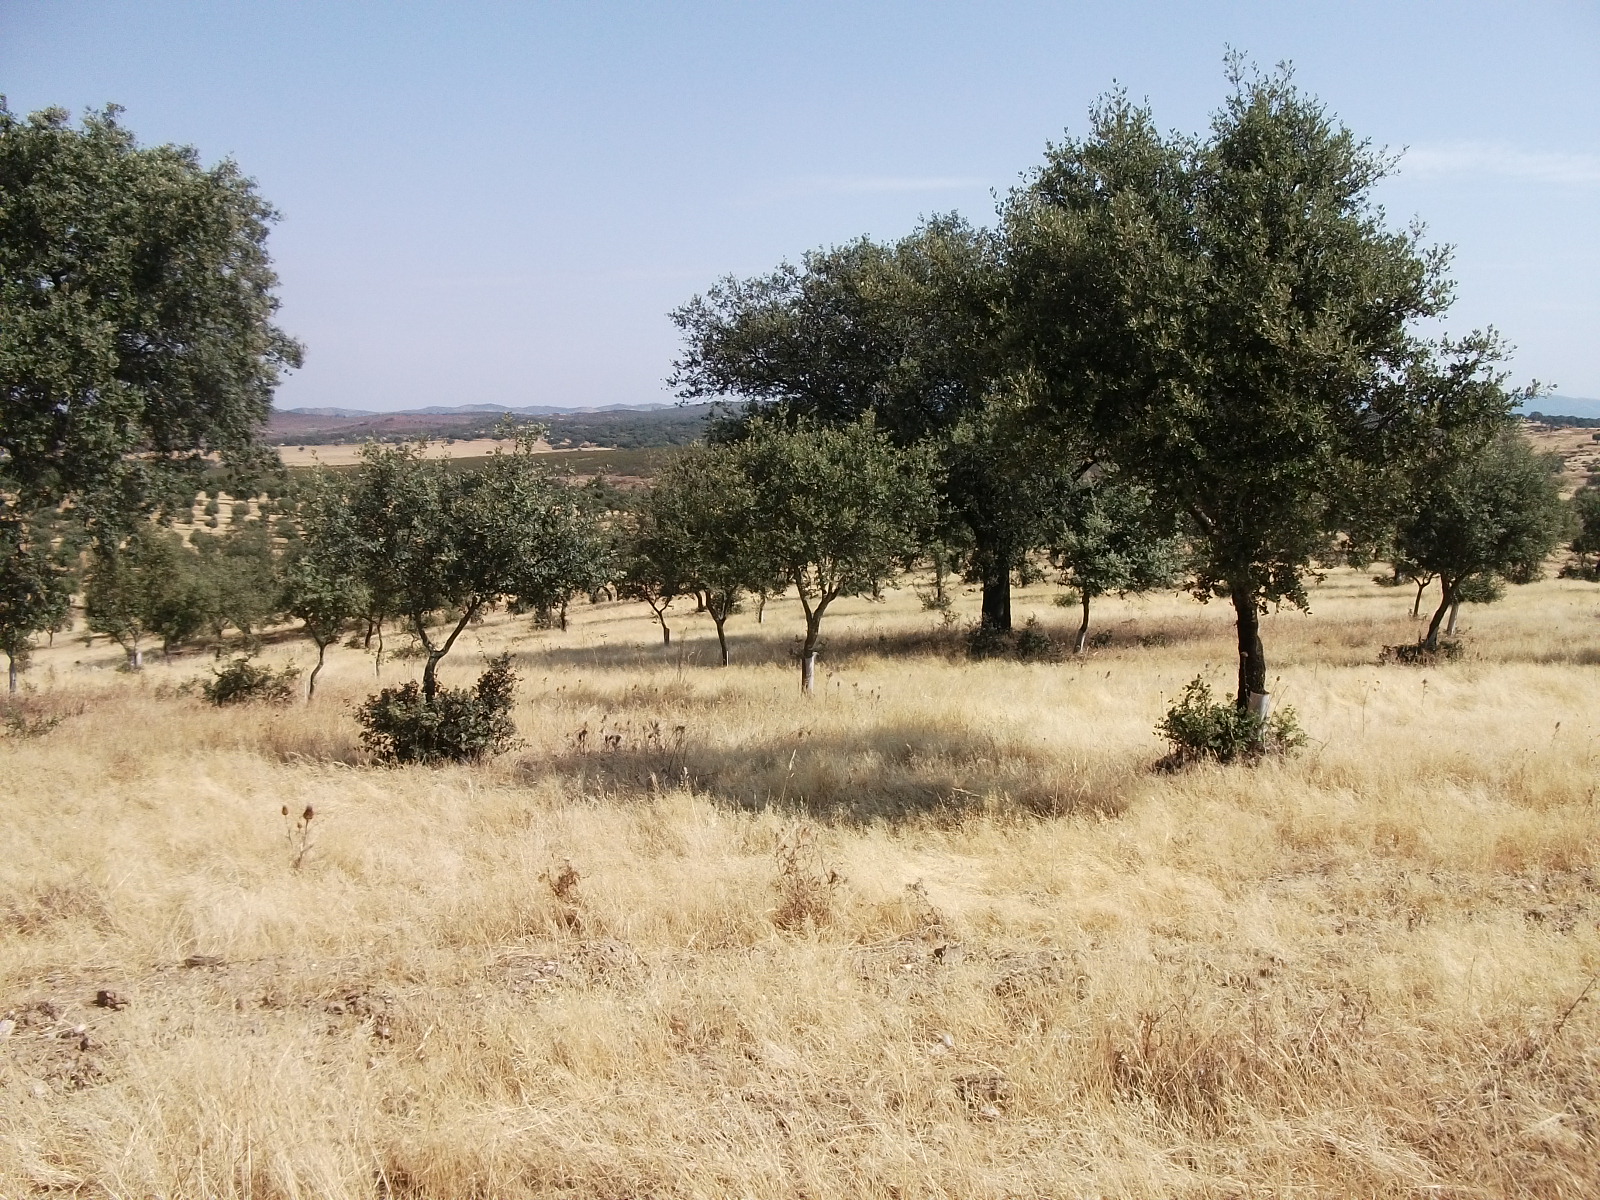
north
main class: Woodland
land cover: Broadleaved woodland
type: broadleaved evergreen forest
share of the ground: 25 - 50 %
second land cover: Spontaneously vegetated surfaces
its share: > 75 %
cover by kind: herbaceous plants 70 %, broadleaved forest trees 30 %
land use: Forestry
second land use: Agriculture (excluding fallow land and kitchen gardens)
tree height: > 5 m
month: June
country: ES
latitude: 37.6897
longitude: -7.1638
